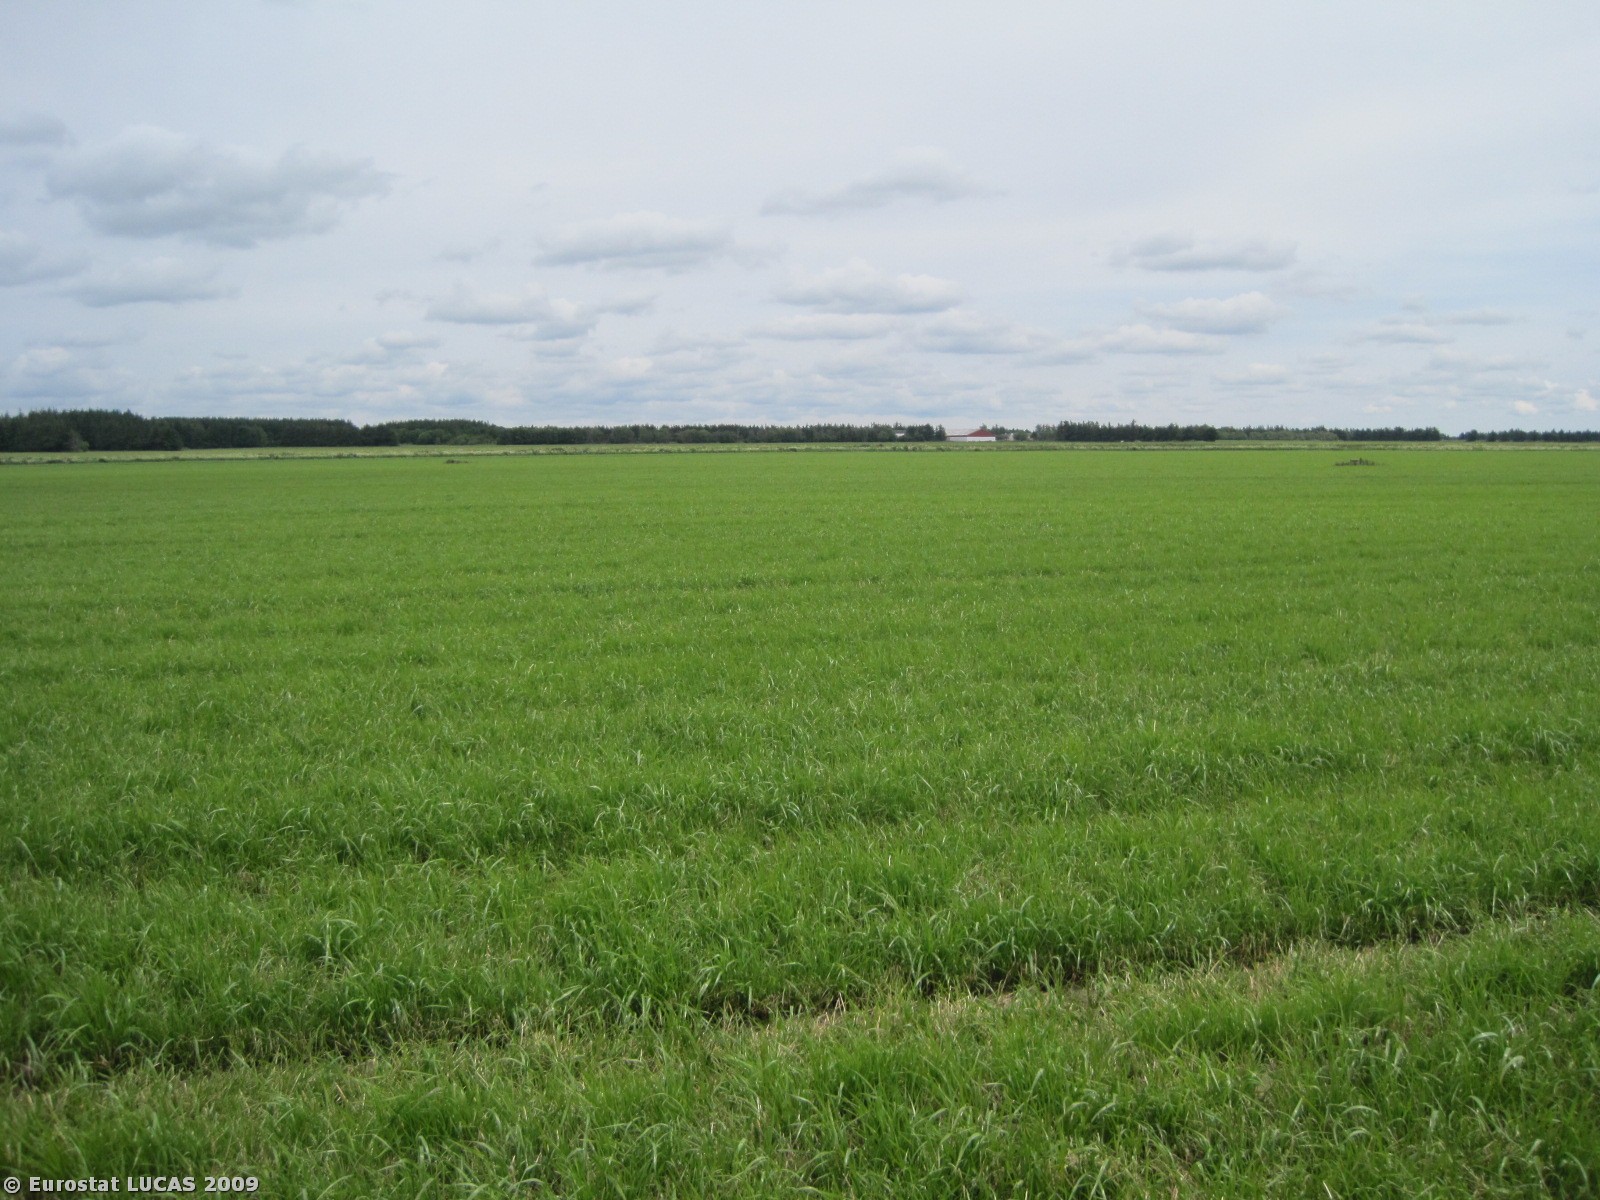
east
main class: Cropland
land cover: Temporary grasslands
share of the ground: > 75 %
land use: Agriculture (excluding fallow land and kitchen gardens)
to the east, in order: Temporary grasslands
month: June
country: DK
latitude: 57.3201
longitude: 9.7513
